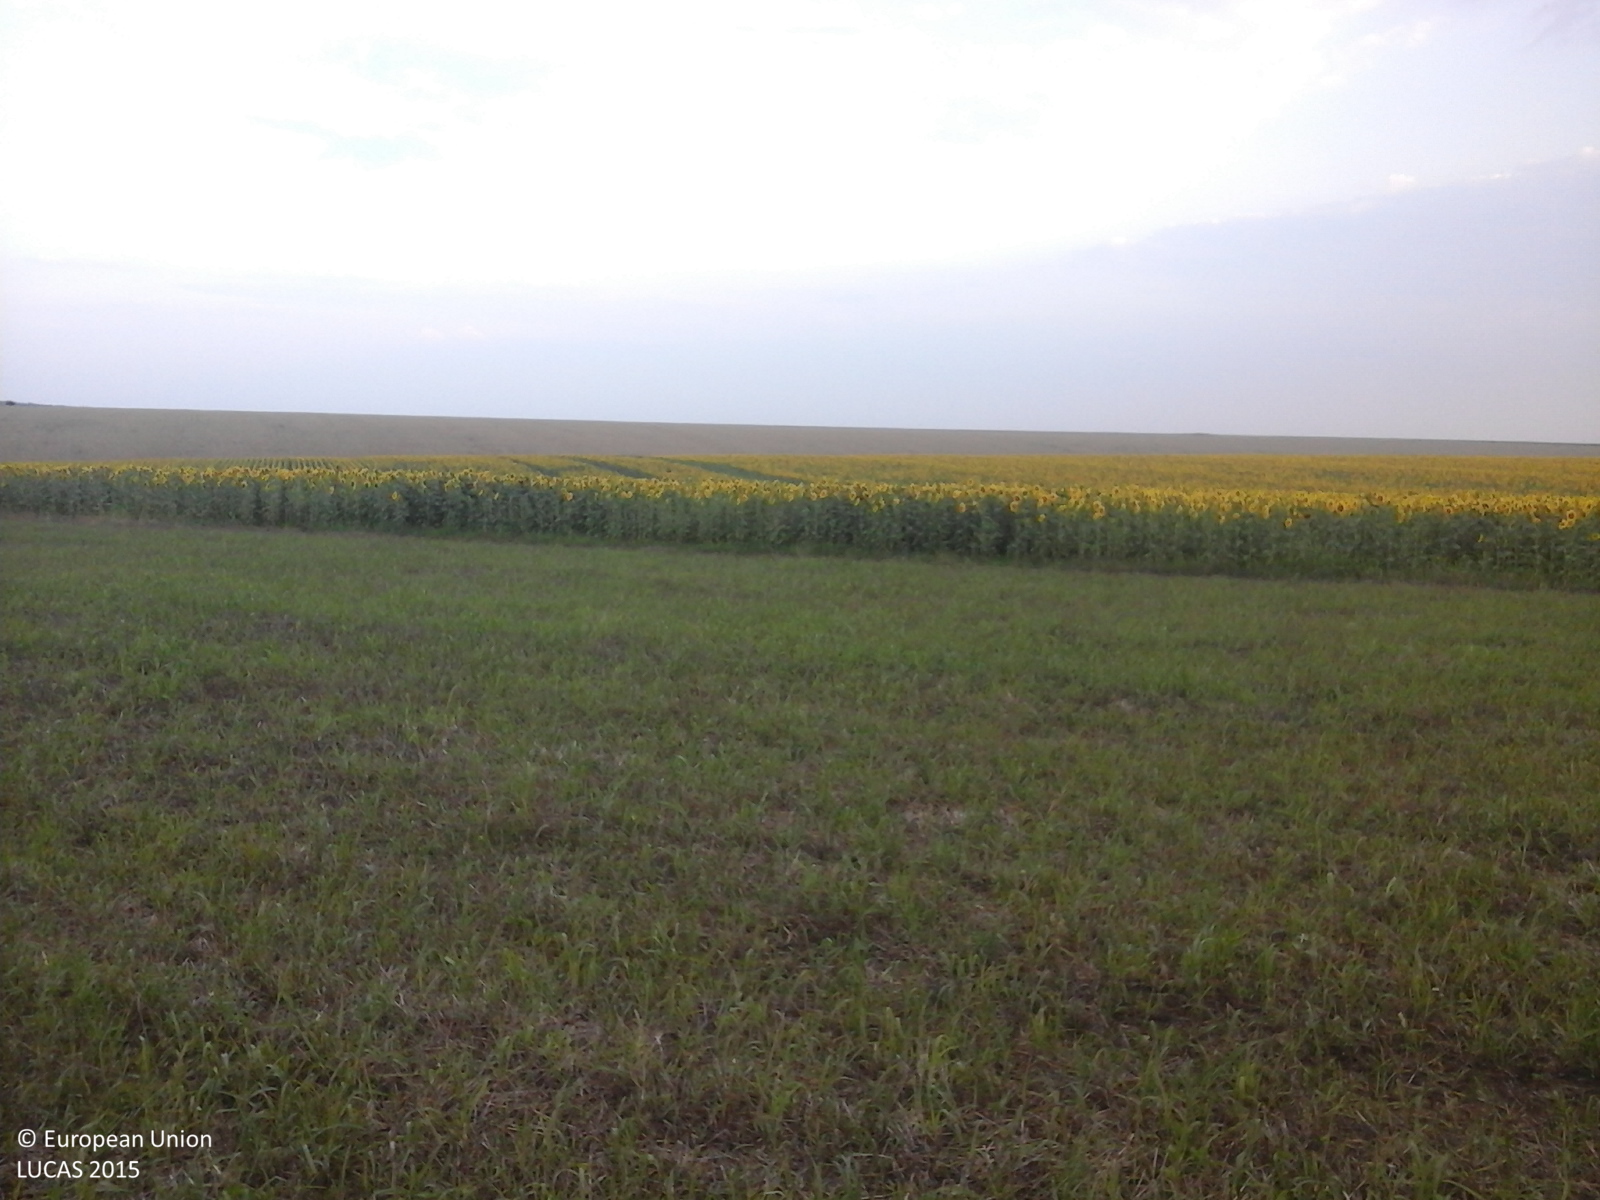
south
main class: Cropland
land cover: Common wheat
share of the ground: > 75 %
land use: Agriculture (excluding fallow land and kitchen gardens)
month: July
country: RO
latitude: 43.9825
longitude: 24.7704
